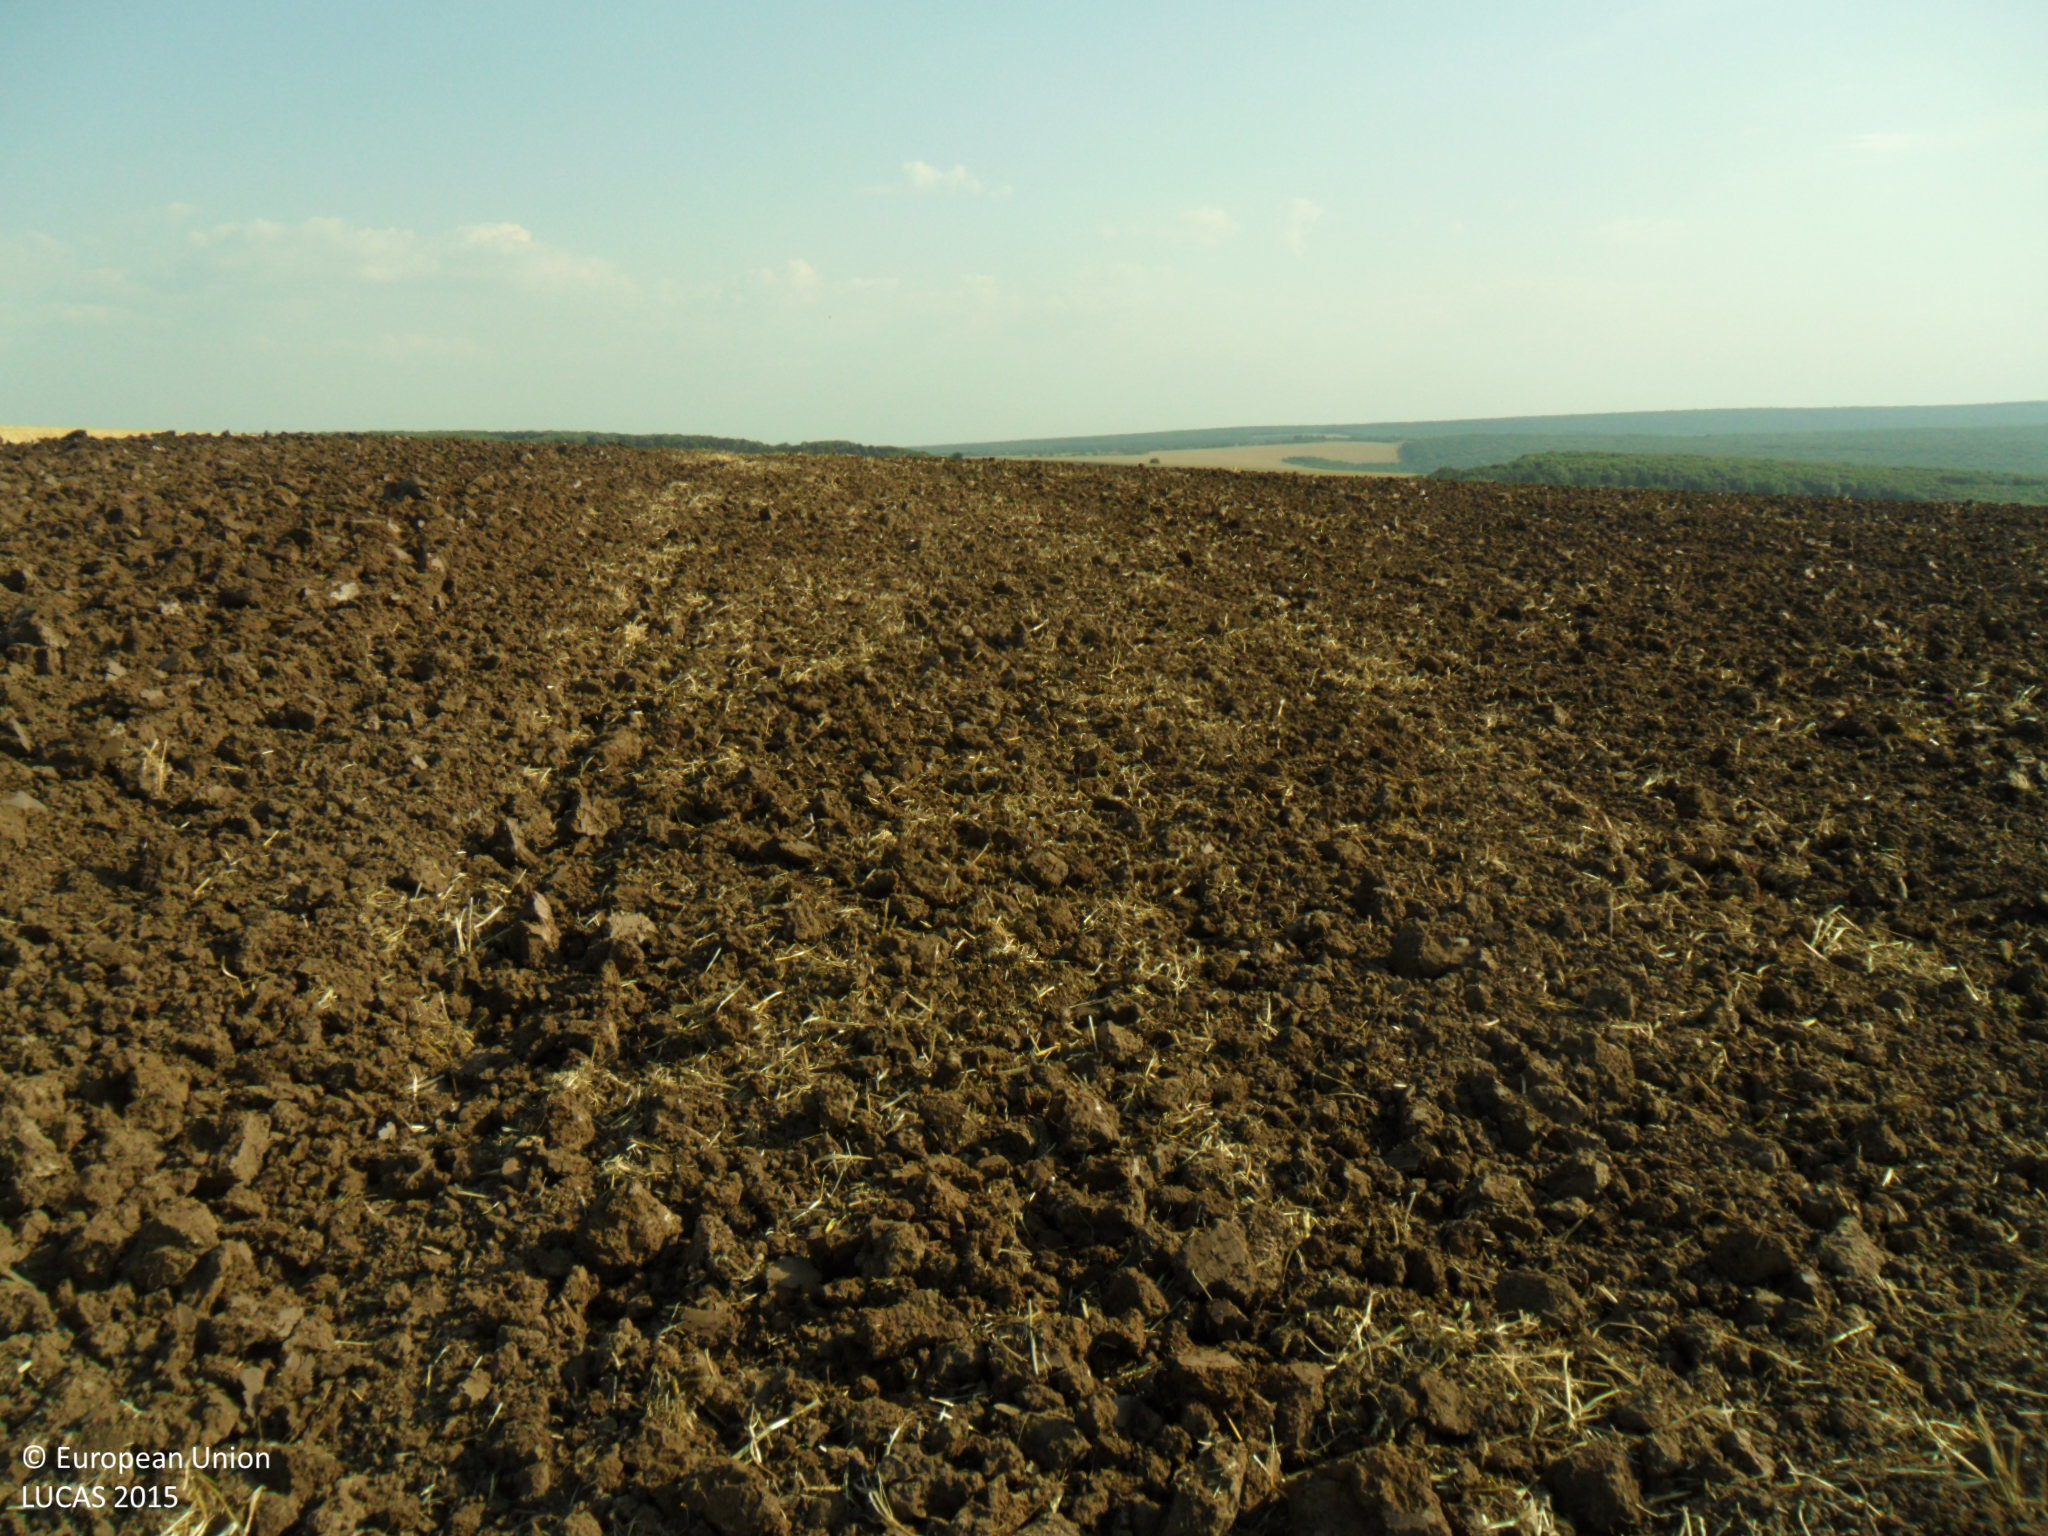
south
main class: Cropland
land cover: Common wheat
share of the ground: < 10 %
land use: Agriculture (excluding fallow land and kitchen gardens)
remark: Harvested field
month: August
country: BG
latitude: 43.4765
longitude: 26.5099
